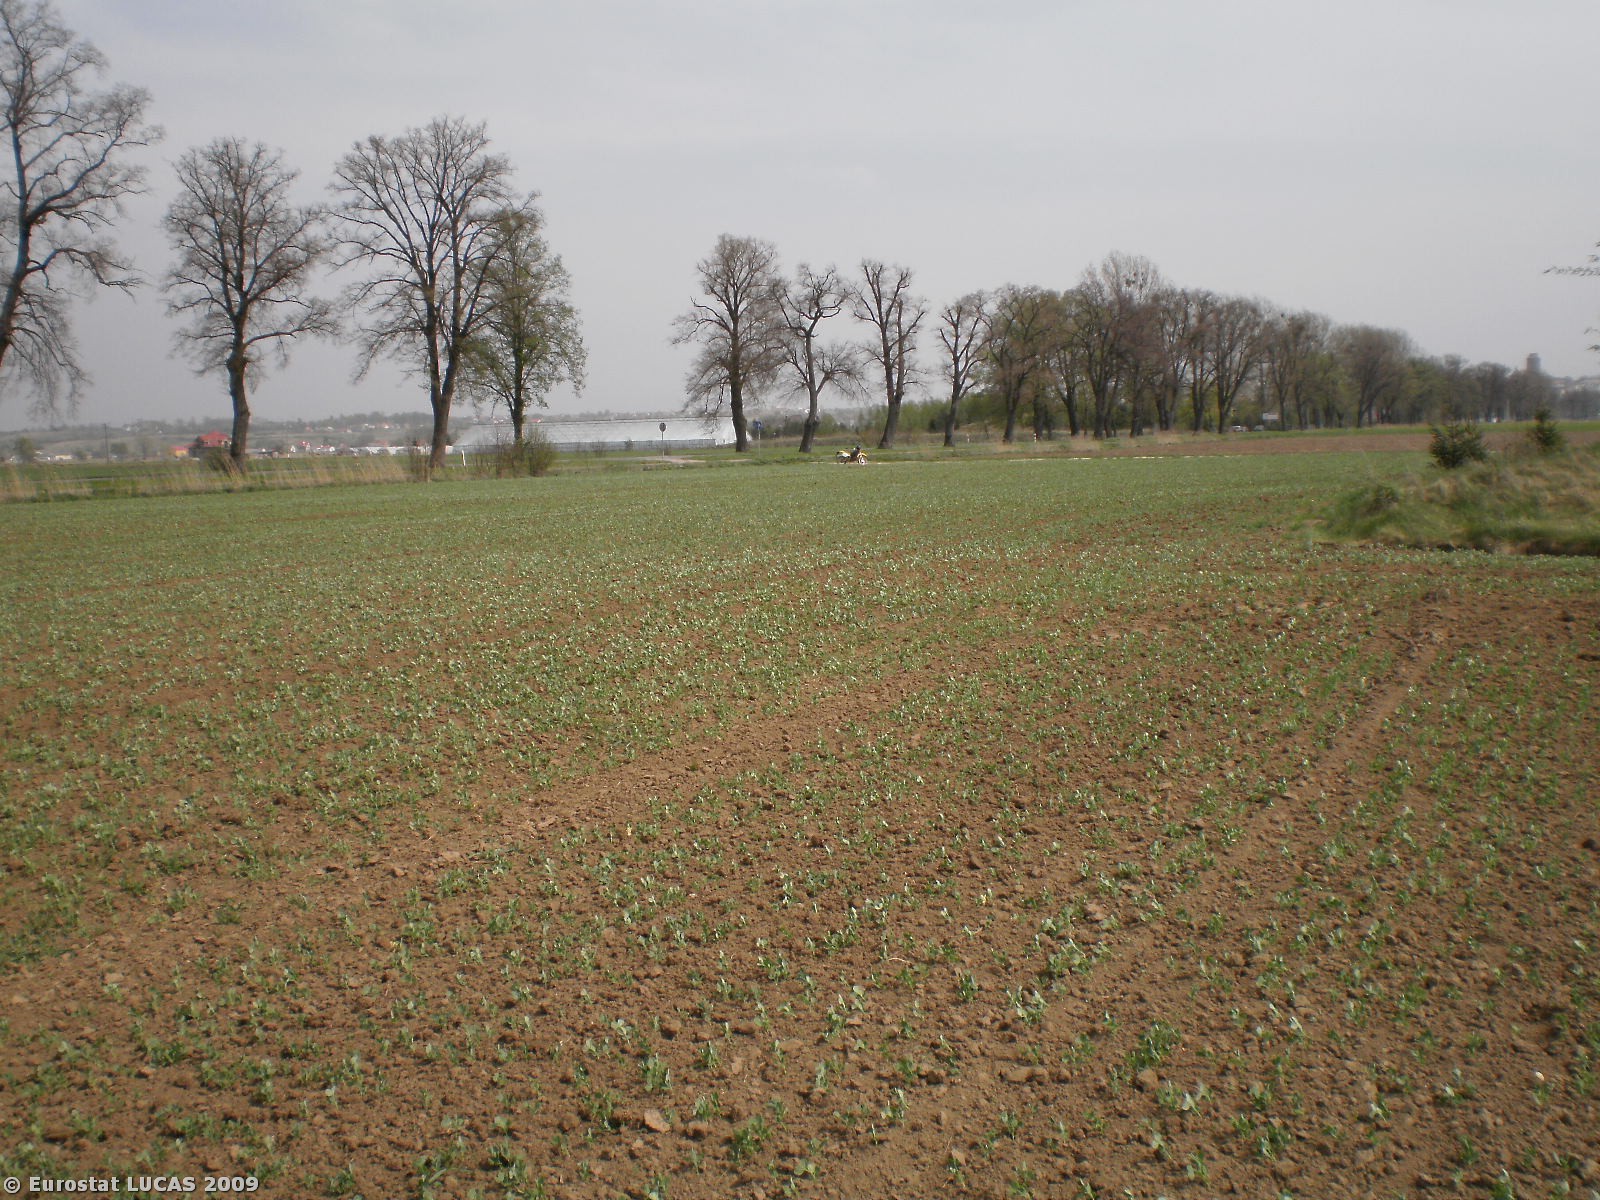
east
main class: Cropland
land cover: Dry pulses
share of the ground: 10 - 25 %
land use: Agriculture (excluding fallow land and kitchen gardens)
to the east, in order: Dry pulses; Grass margins; Tracks; Grassland without tree/shrub cover; Lines of trees; Paved roads, cycling and walking lanes; Grassland without tree/shrub cover; Ditches and canals; Grass margins; Common wheat; Other fresh vegetables; Spontaneously vegetated surfaces; Other fresh vegetables
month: April
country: PL
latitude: 53.7437
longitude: 18.8912
